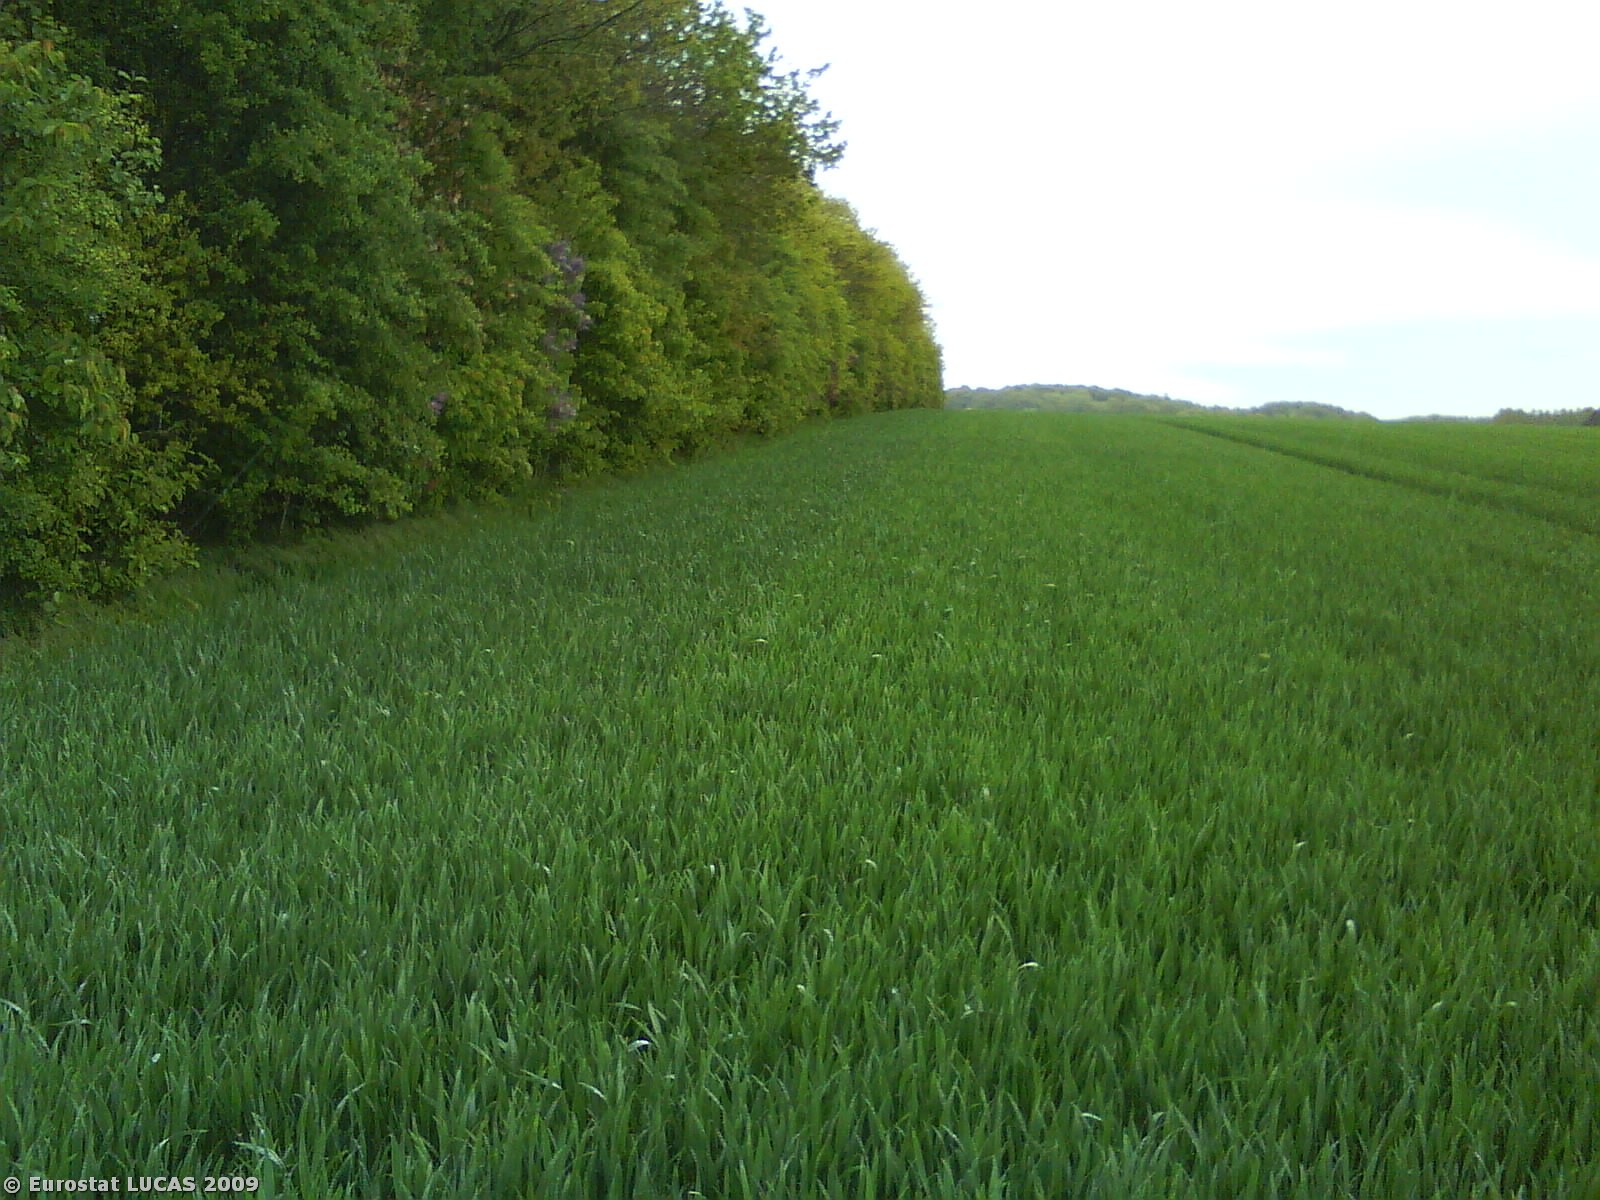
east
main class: Cropland
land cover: Common wheat
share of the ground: > 75 %
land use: Agriculture (excluding fallow land and kitchen gardens)
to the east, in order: Common wheat; Broadleaved woodland; Artificial constructions in urban areas; Broadleaved woodland; Fences; Grass margins; Paved roads, cycling and walking lanes; Grass margins; Common wheat; Grass margins; Common wheat
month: May
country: DK
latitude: 56.3315
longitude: 10.1454
